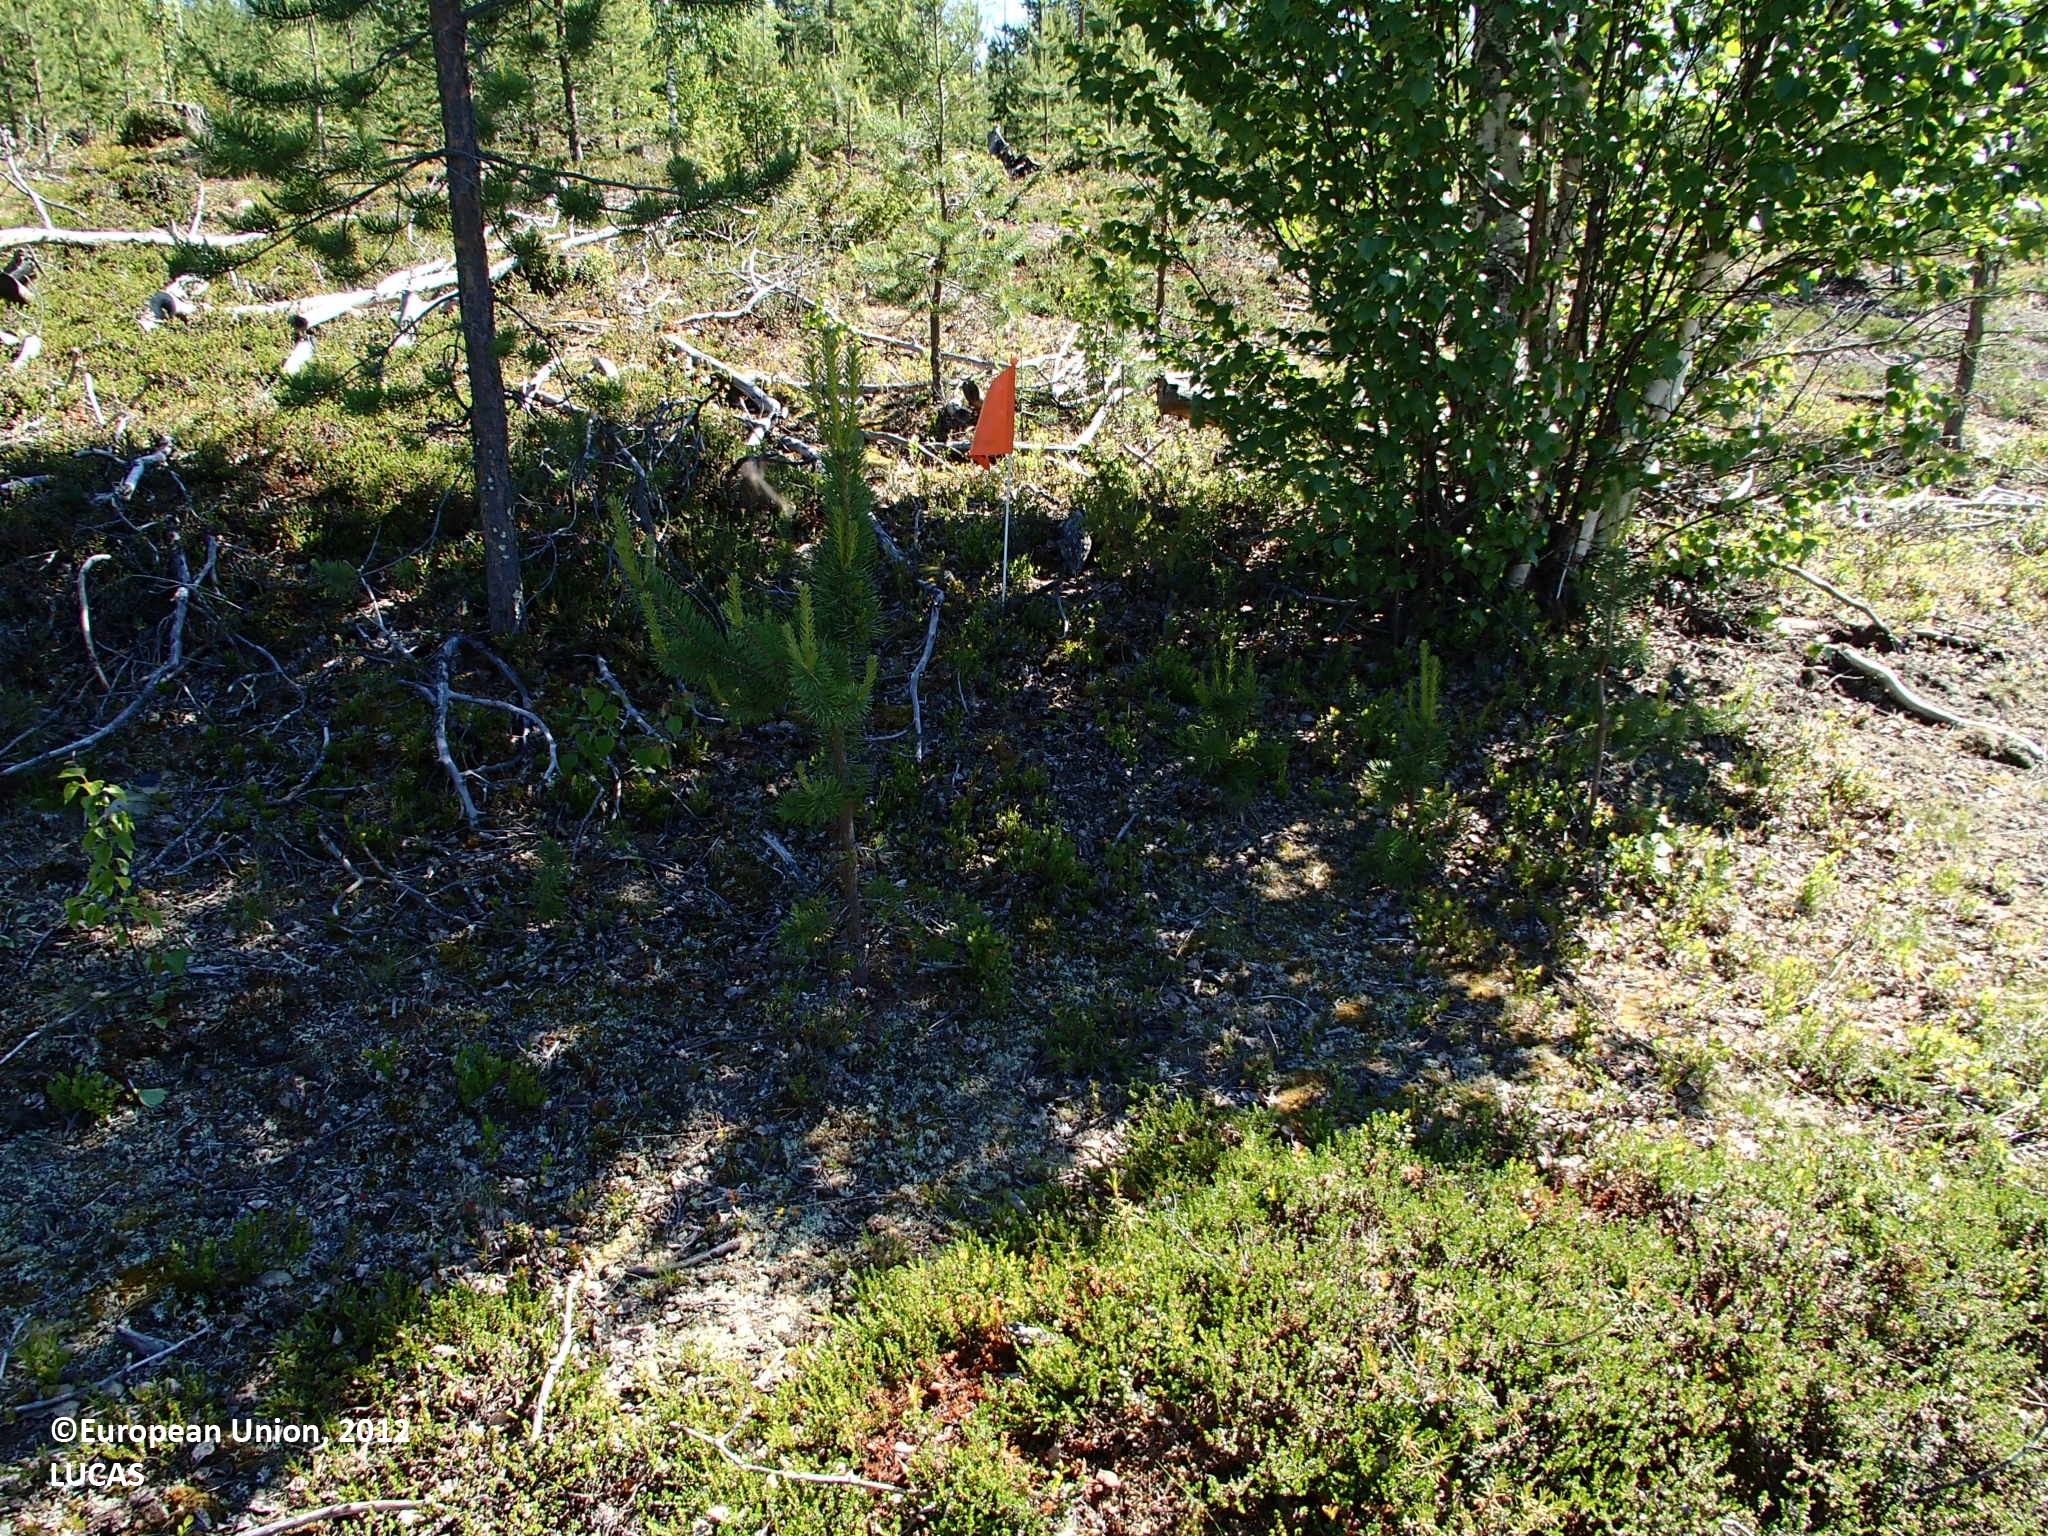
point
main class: Woodland
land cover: Other mixed woodland
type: boreal forest
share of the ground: 10 - 25 %
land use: Forestry
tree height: > 5 m
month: July
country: FI
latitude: 67.1153
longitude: 26.6497
